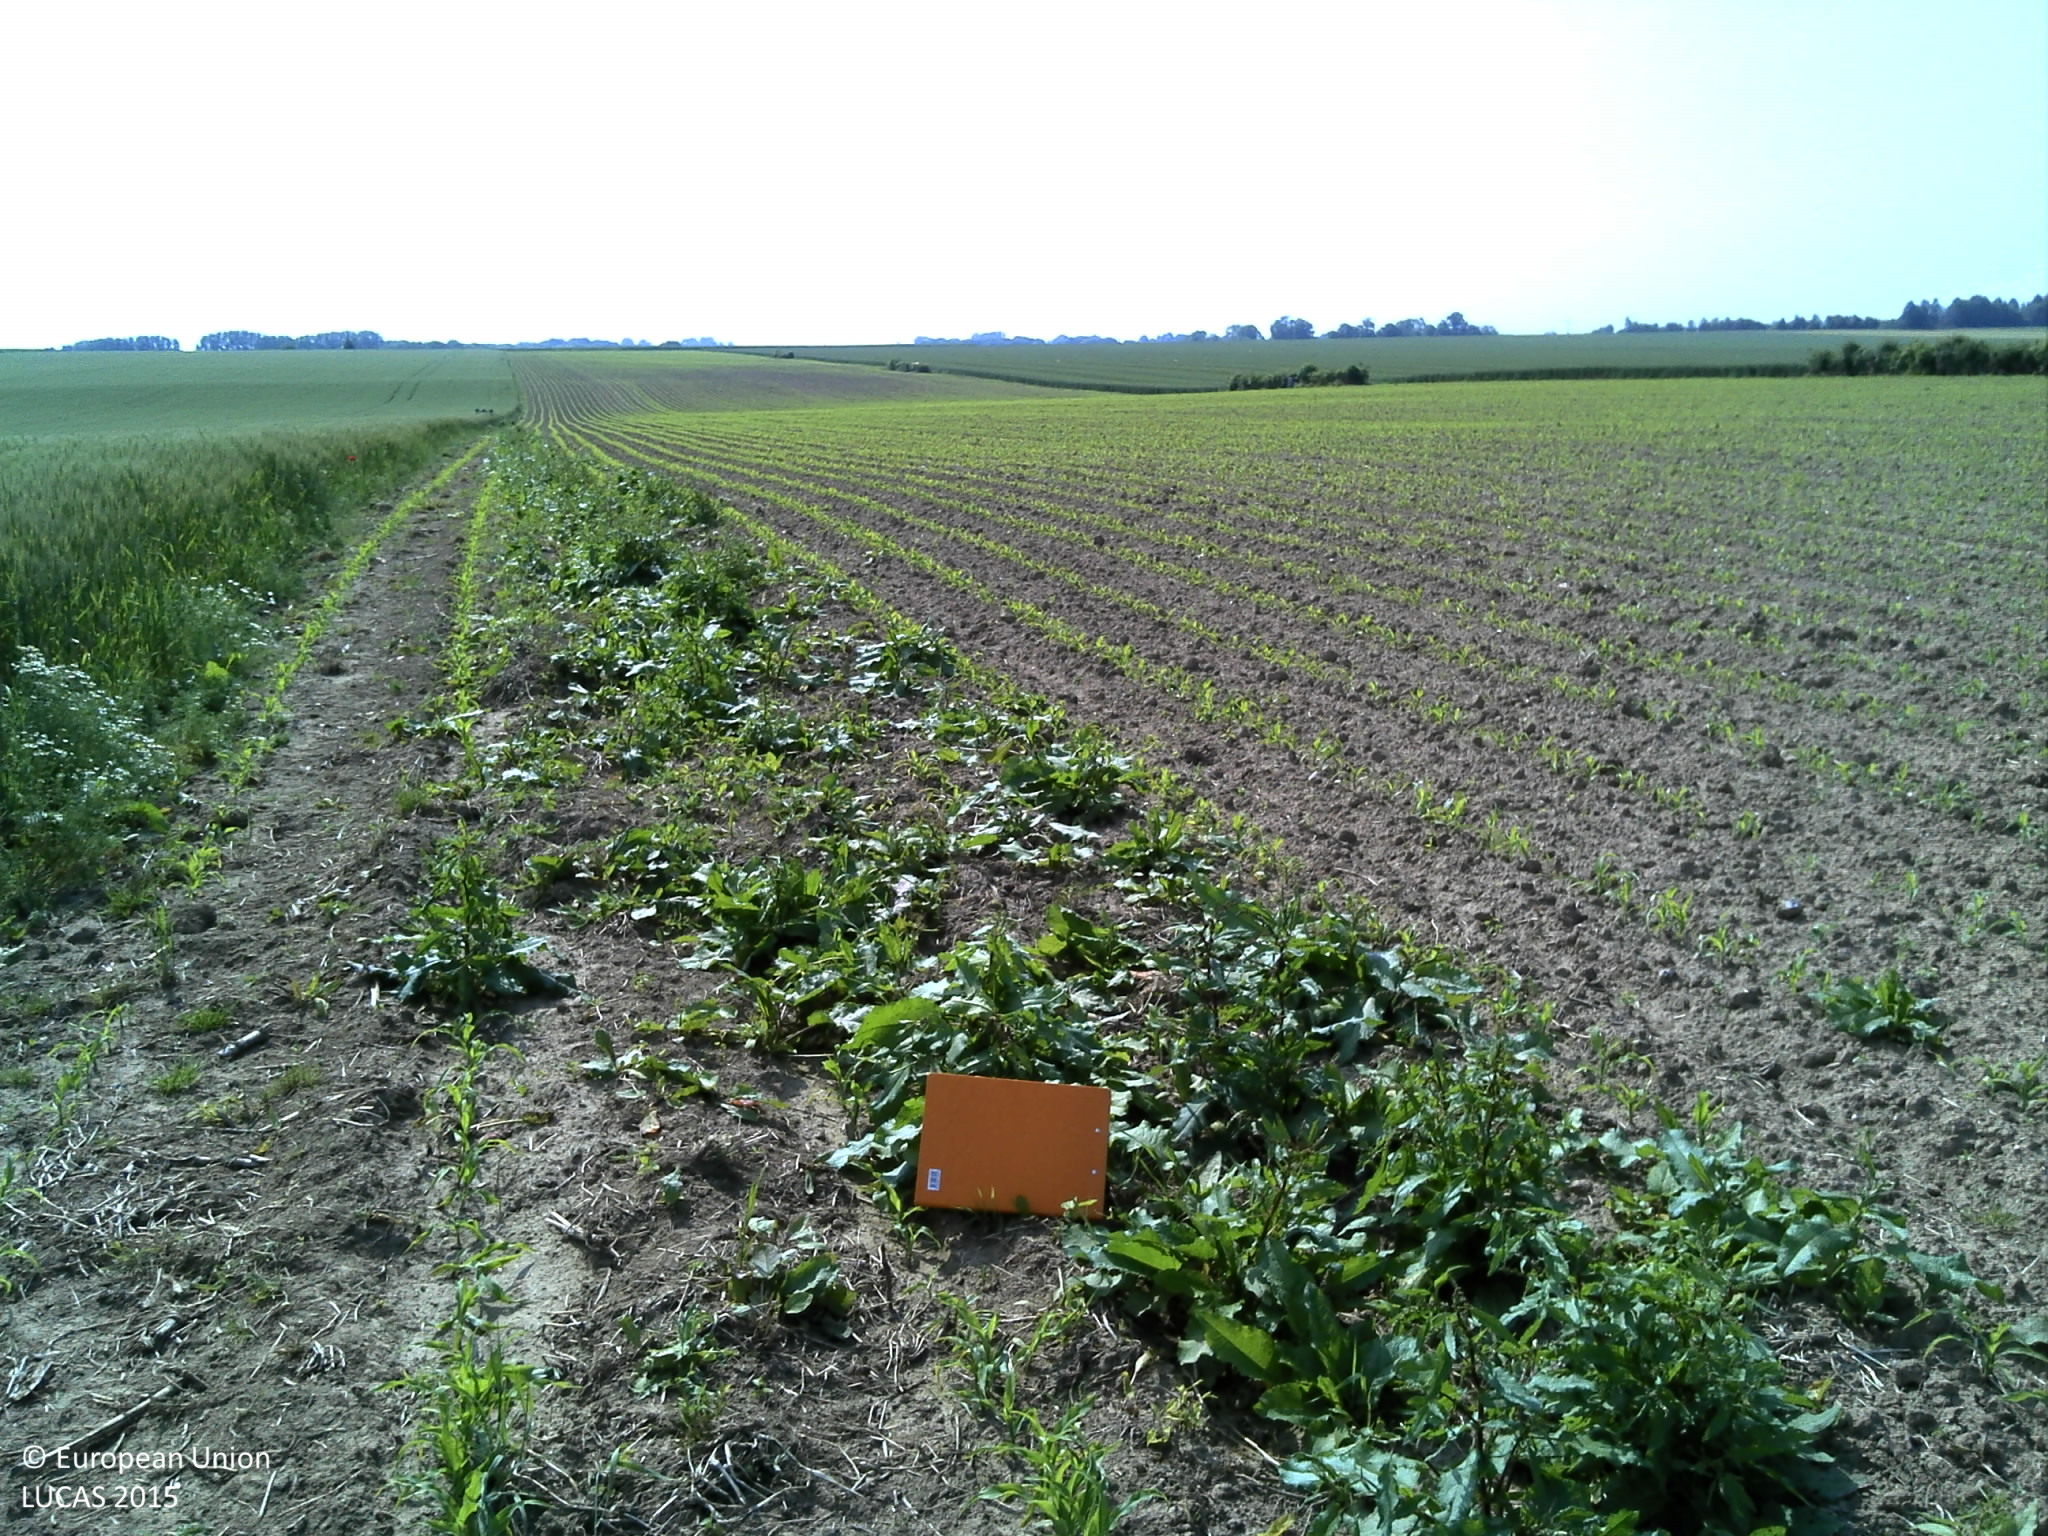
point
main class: Cropland
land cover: Maize
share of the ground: 10 - 25 %
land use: Agriculture (excluding fallow land and kitchen gardens)
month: June
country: FR
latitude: 49.7438
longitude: 1.0828
